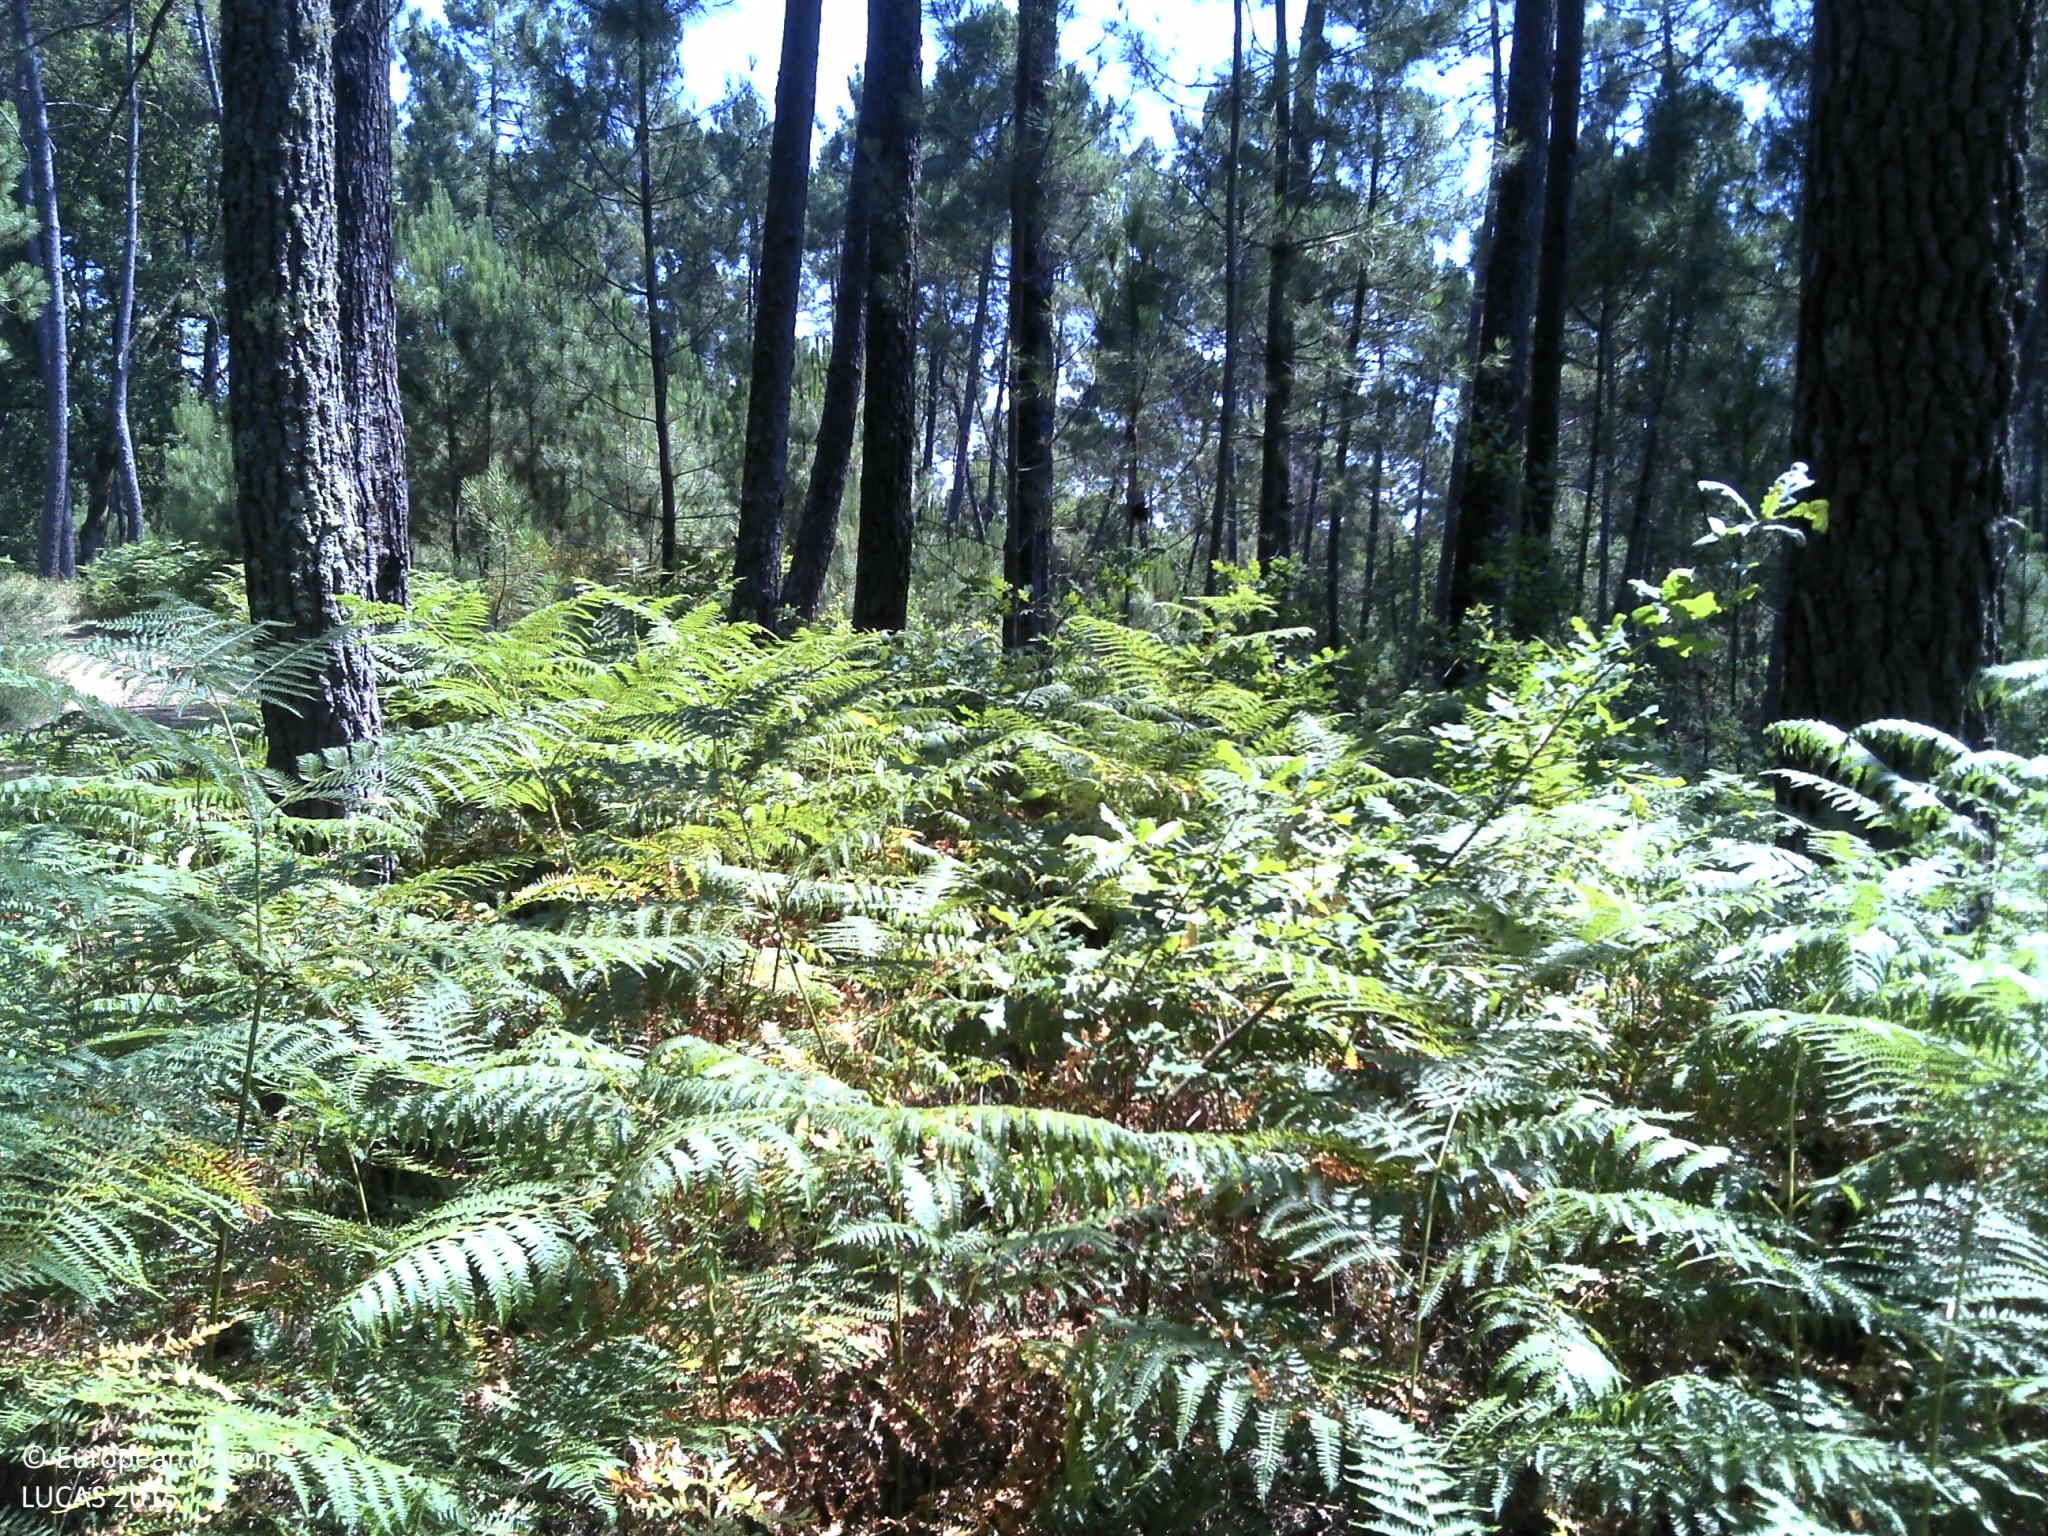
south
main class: Woodland
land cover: Pine dominated coniferous woodland
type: coniferous forest of the mediterranean region
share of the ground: 10 - 25 %
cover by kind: shrubs 85 %, coniferous forest trees 15 %
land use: Forestry
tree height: > 5 m
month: July
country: PT
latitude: 40.9143
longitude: -7.9025
